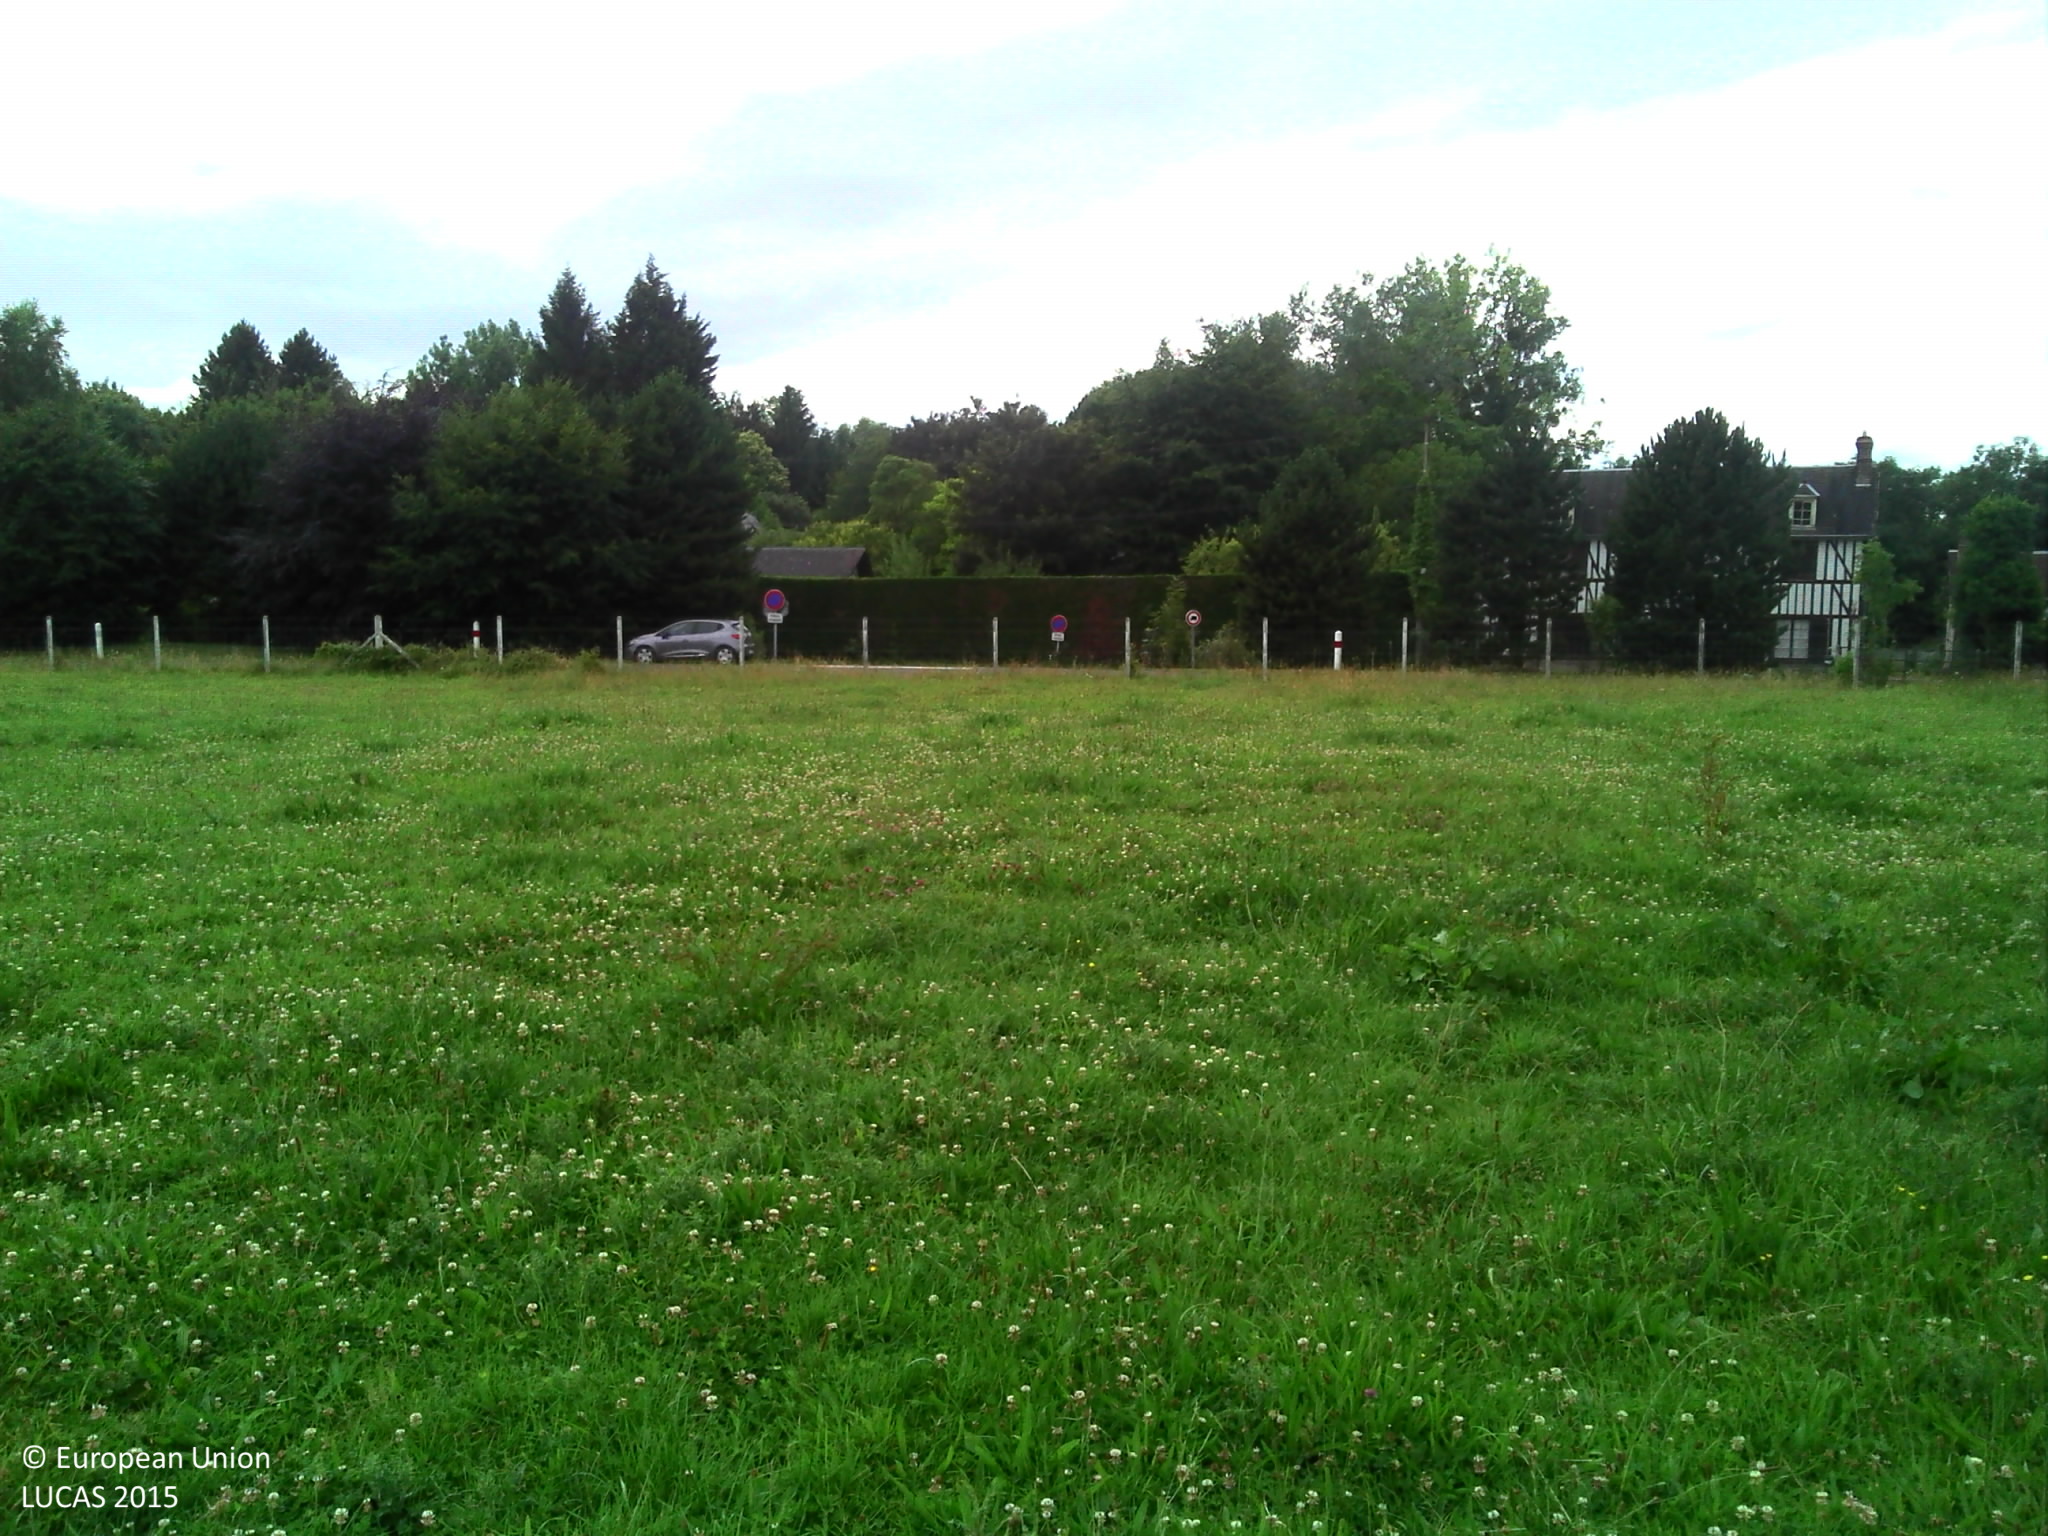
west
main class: Grassland
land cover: Grassland without tree/shrub cover
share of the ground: > 75 %
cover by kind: herbaceous plants 100 %
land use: Agriculture (excluding fallow land and kitchen gardens)
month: July
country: FR
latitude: 49.3727
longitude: 0.3175
